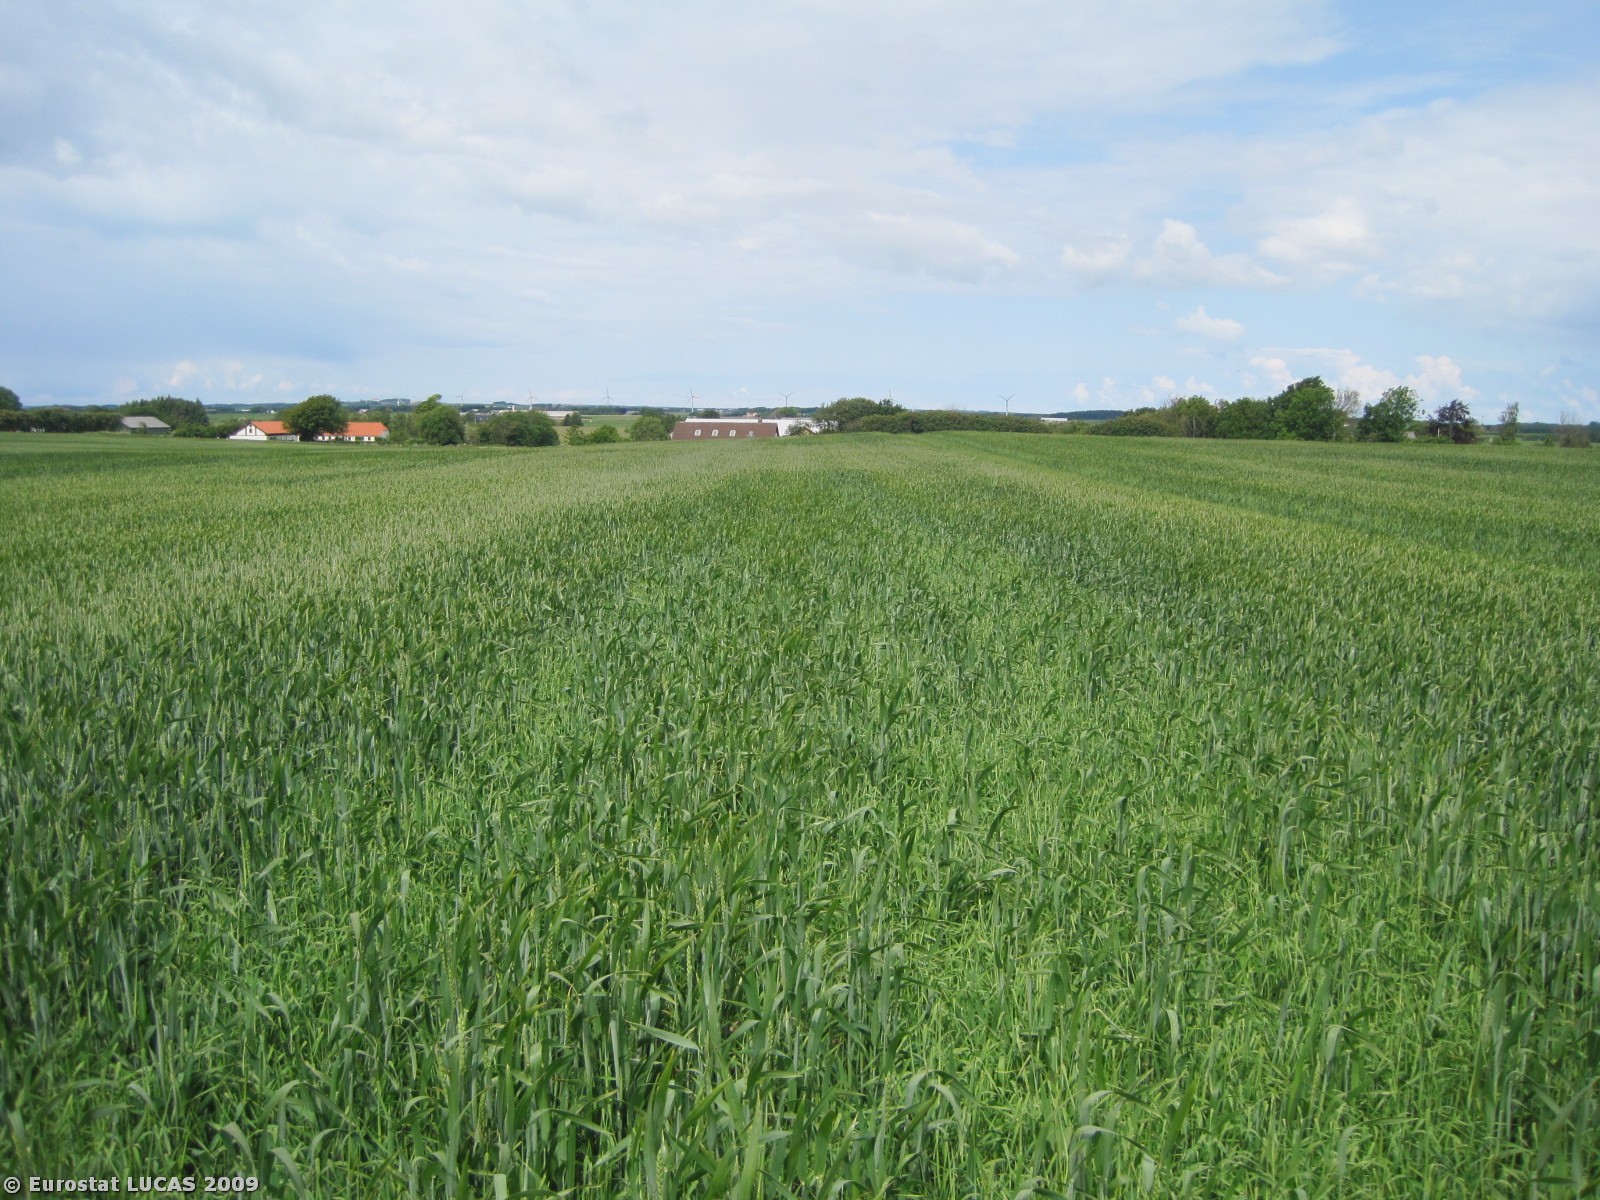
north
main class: Cropland
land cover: Common wheat
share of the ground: 50 - 75 %
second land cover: Barley
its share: 10 - 25 %
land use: Agriculture (excluding fallow land and kitchen gardens)
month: June
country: DK
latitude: 57.3023
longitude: 9.8509
